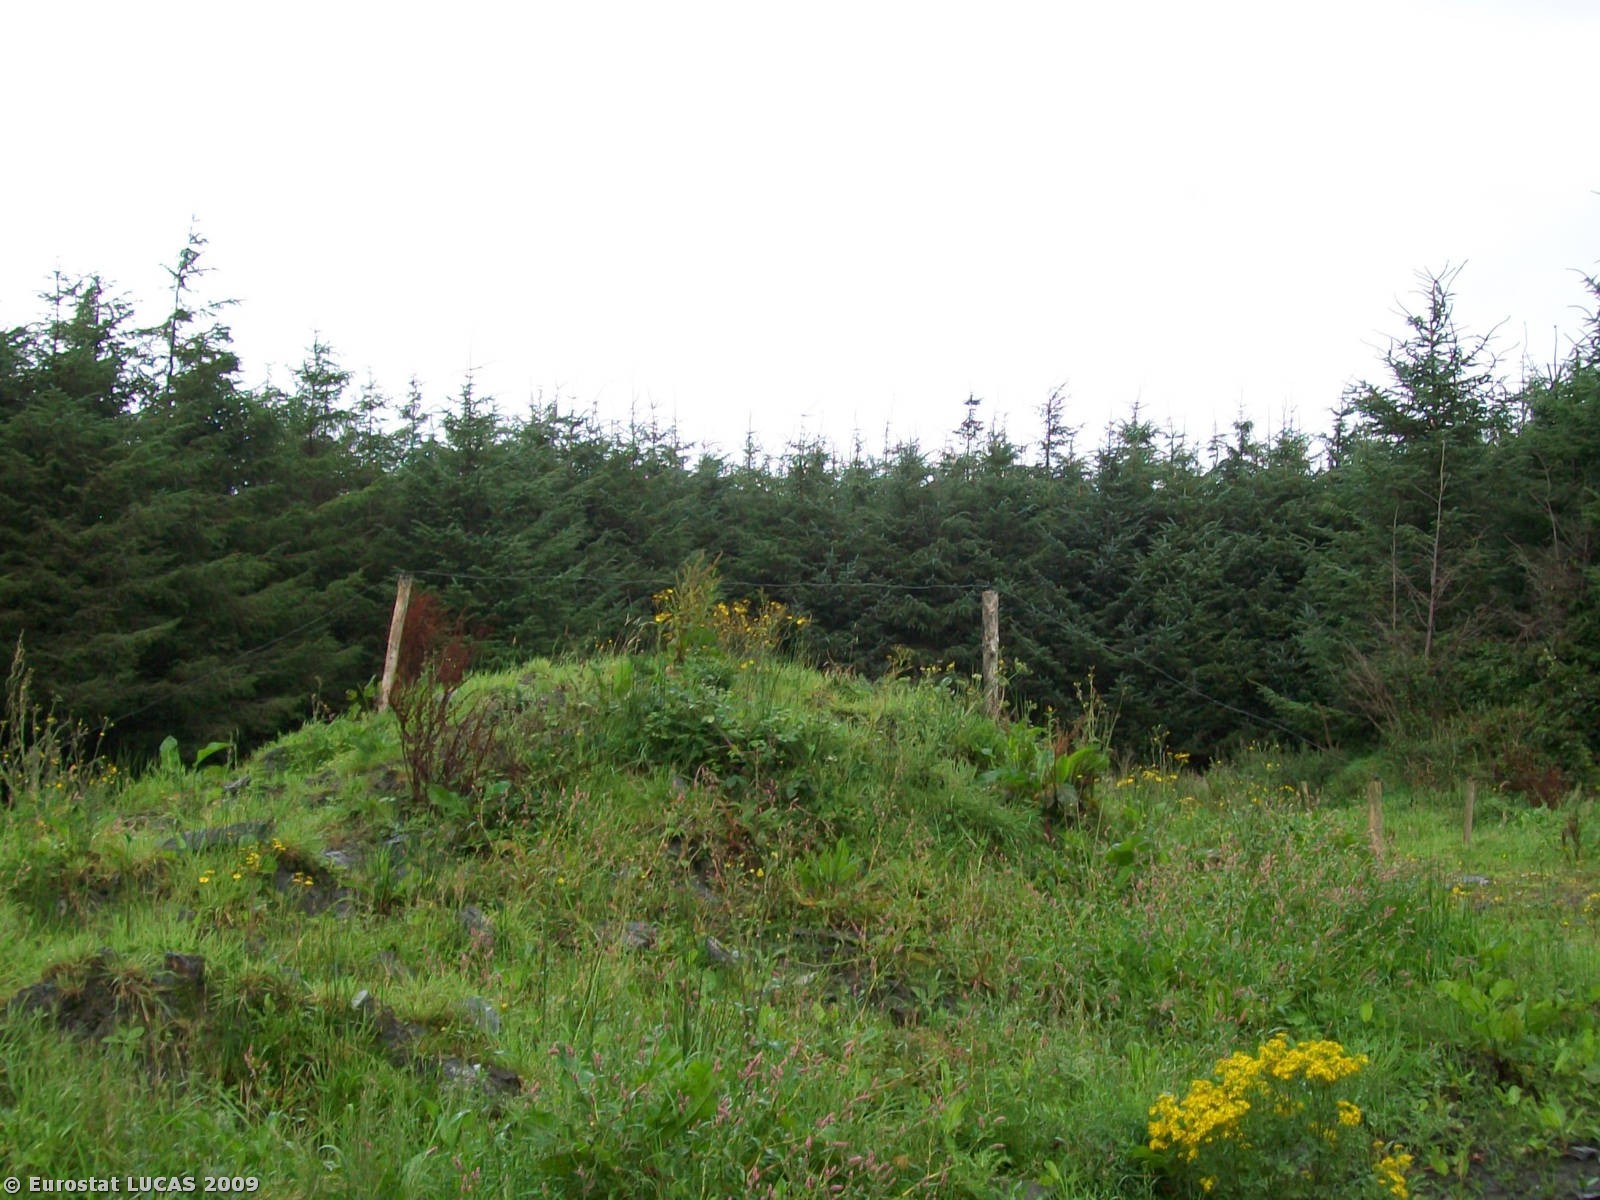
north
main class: Woodland
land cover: Coniferous woodland
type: plantations and self-sown exotic forest
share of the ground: > 75 %
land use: Forestry
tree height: > 5 m
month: August
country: IE
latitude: 52.9969
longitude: -9.2805
